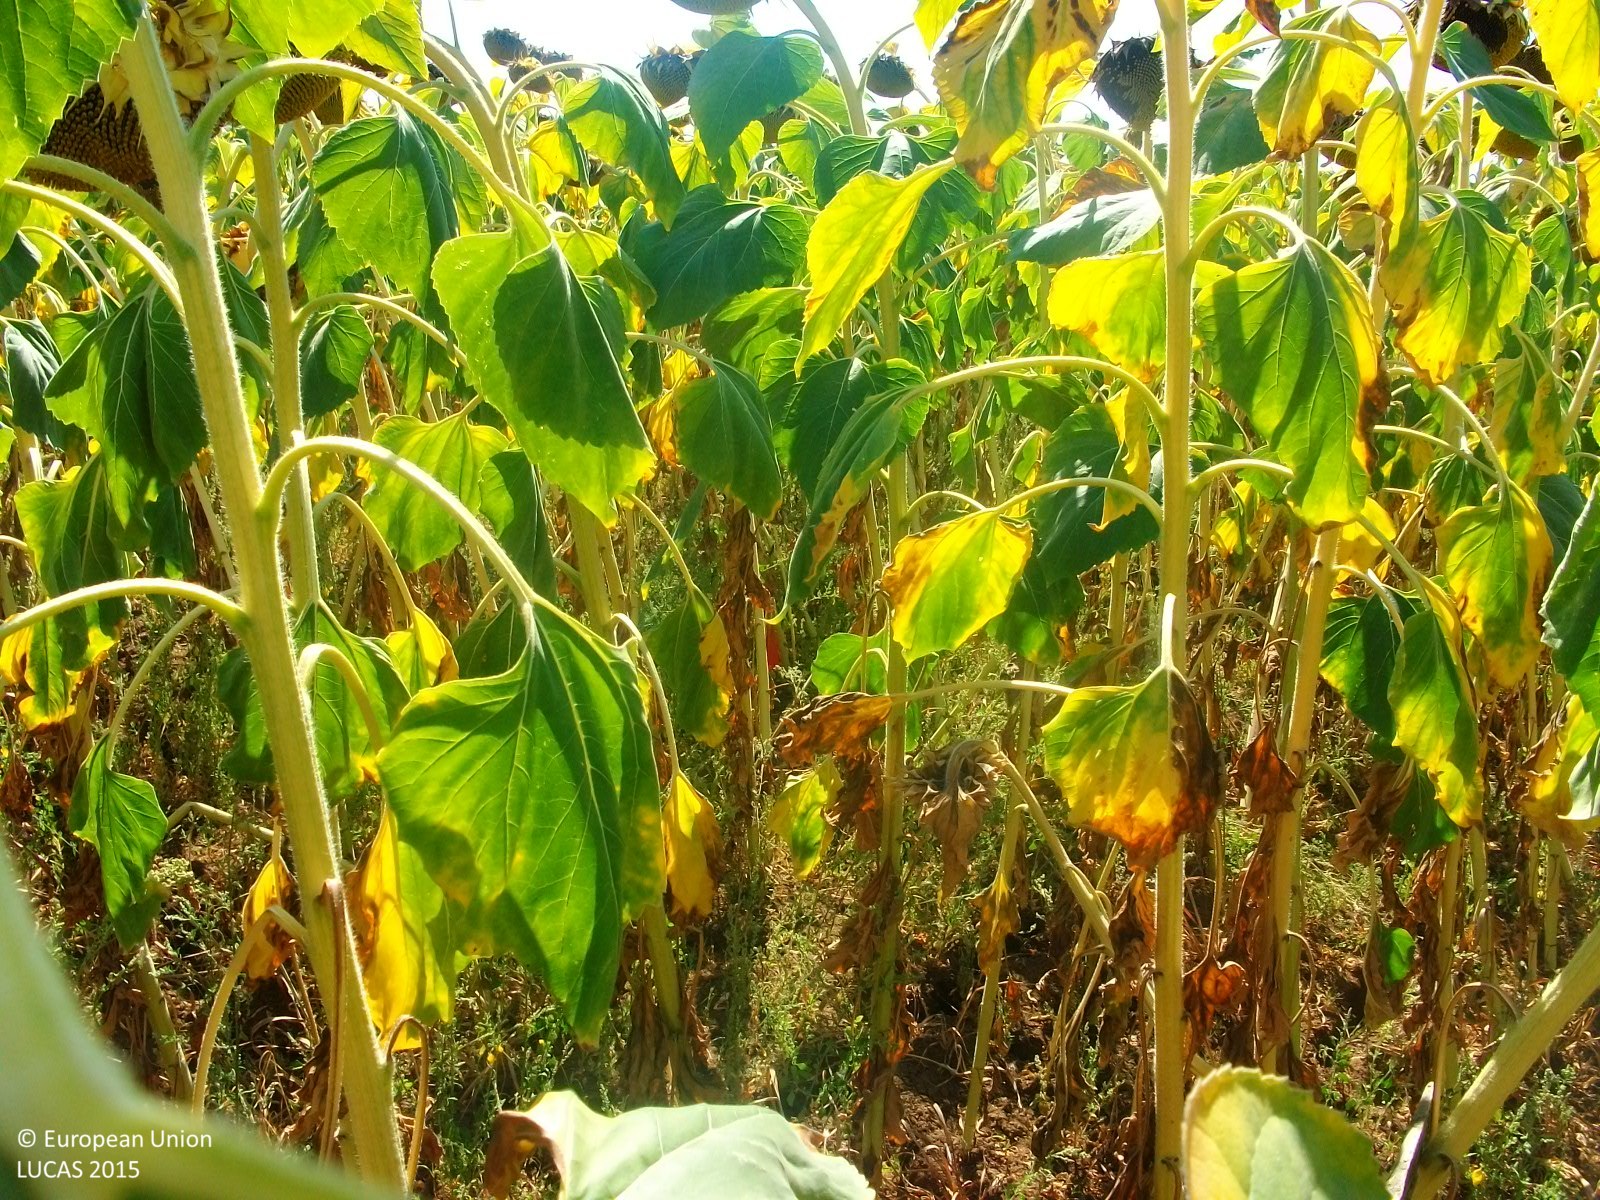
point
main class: Cropland
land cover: Sunflower
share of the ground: > 75 %
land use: Agriculture (excluding fallow land and kitchen gardens)
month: July
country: GR
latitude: 41.4139
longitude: 26.3079
